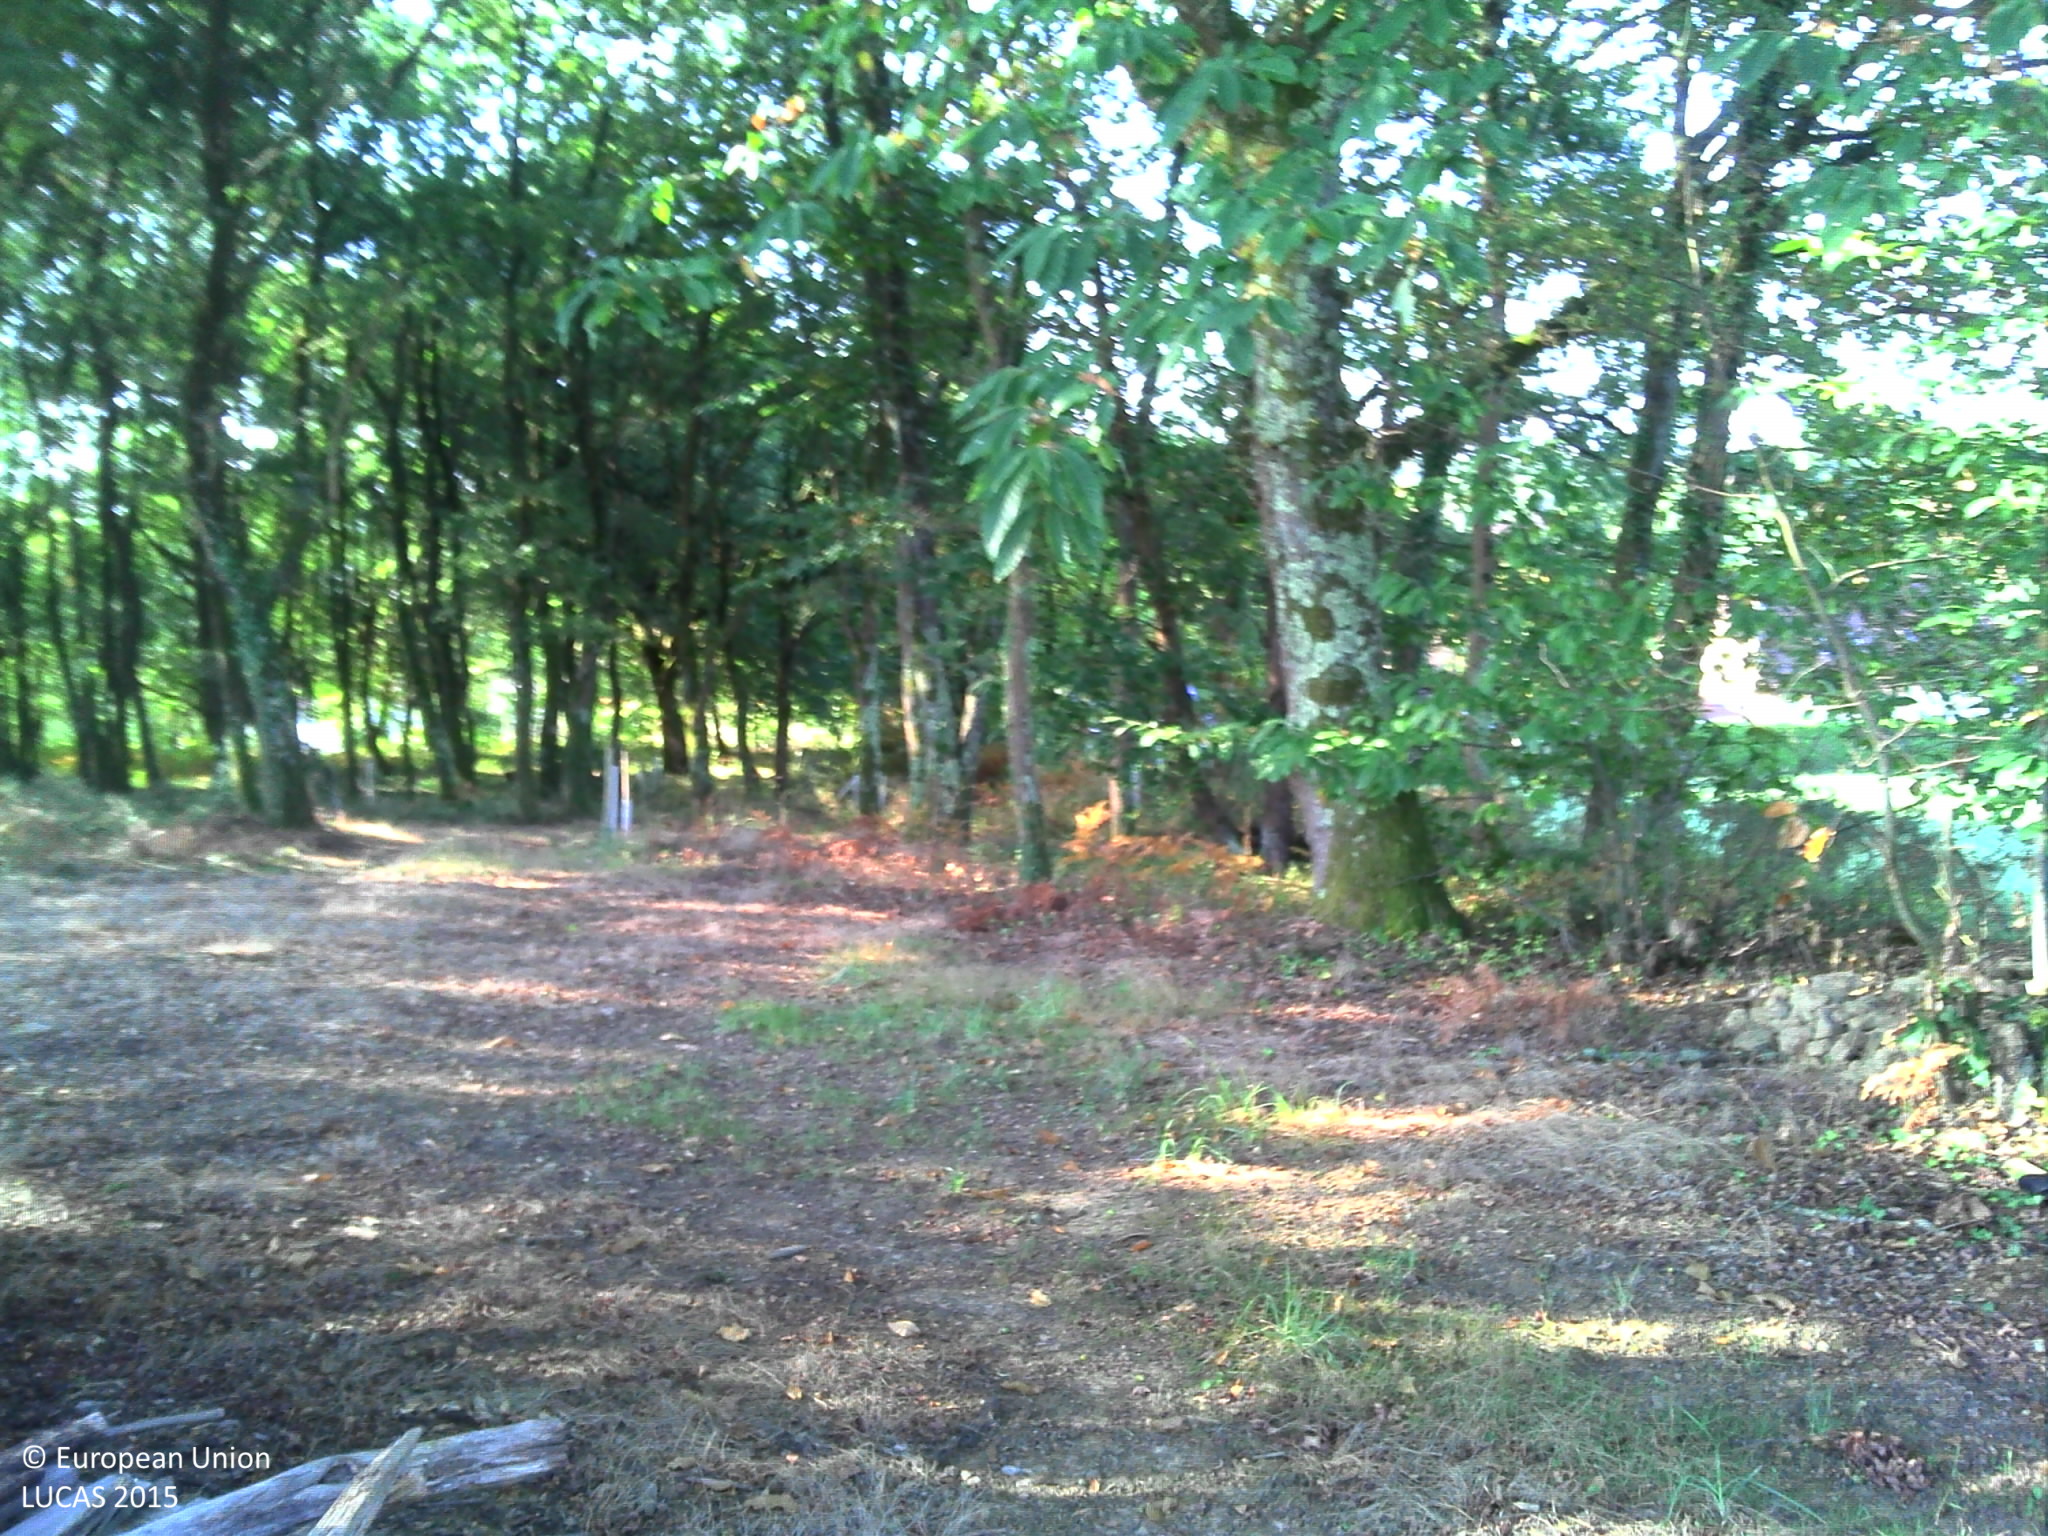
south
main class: Woodland
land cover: Broadleaved woodland
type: acidophilous oak and oak-birch forest
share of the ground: > 75 %
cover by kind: broadleaved forest trees 80 %, herbaceous plants 20 %
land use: Forestry
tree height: > 5 m
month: September
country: FR
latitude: 43.5190
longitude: -0.7374
